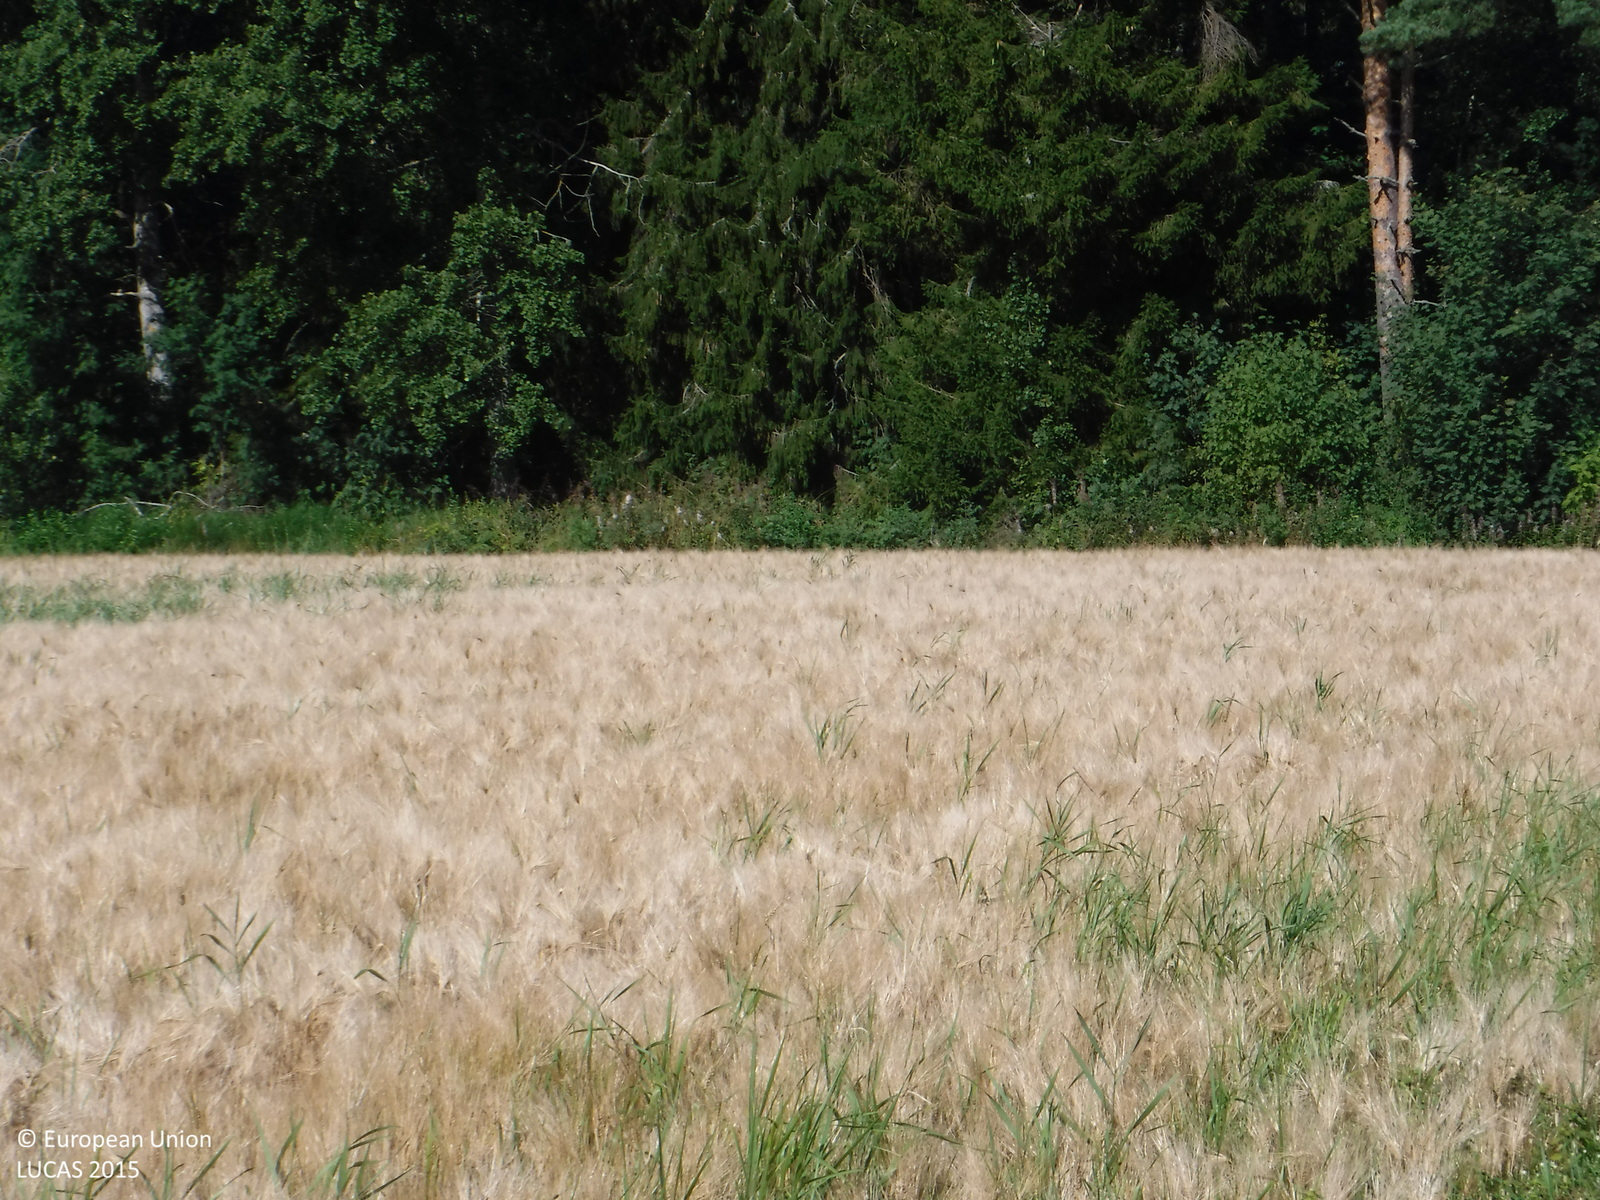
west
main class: Cropland
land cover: Barley
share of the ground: > 75 %
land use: Agriculture (excluding fallow land and kitchen gardens)
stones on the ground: < 10 %
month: August
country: FI
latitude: 61.1297
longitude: 21.7340
